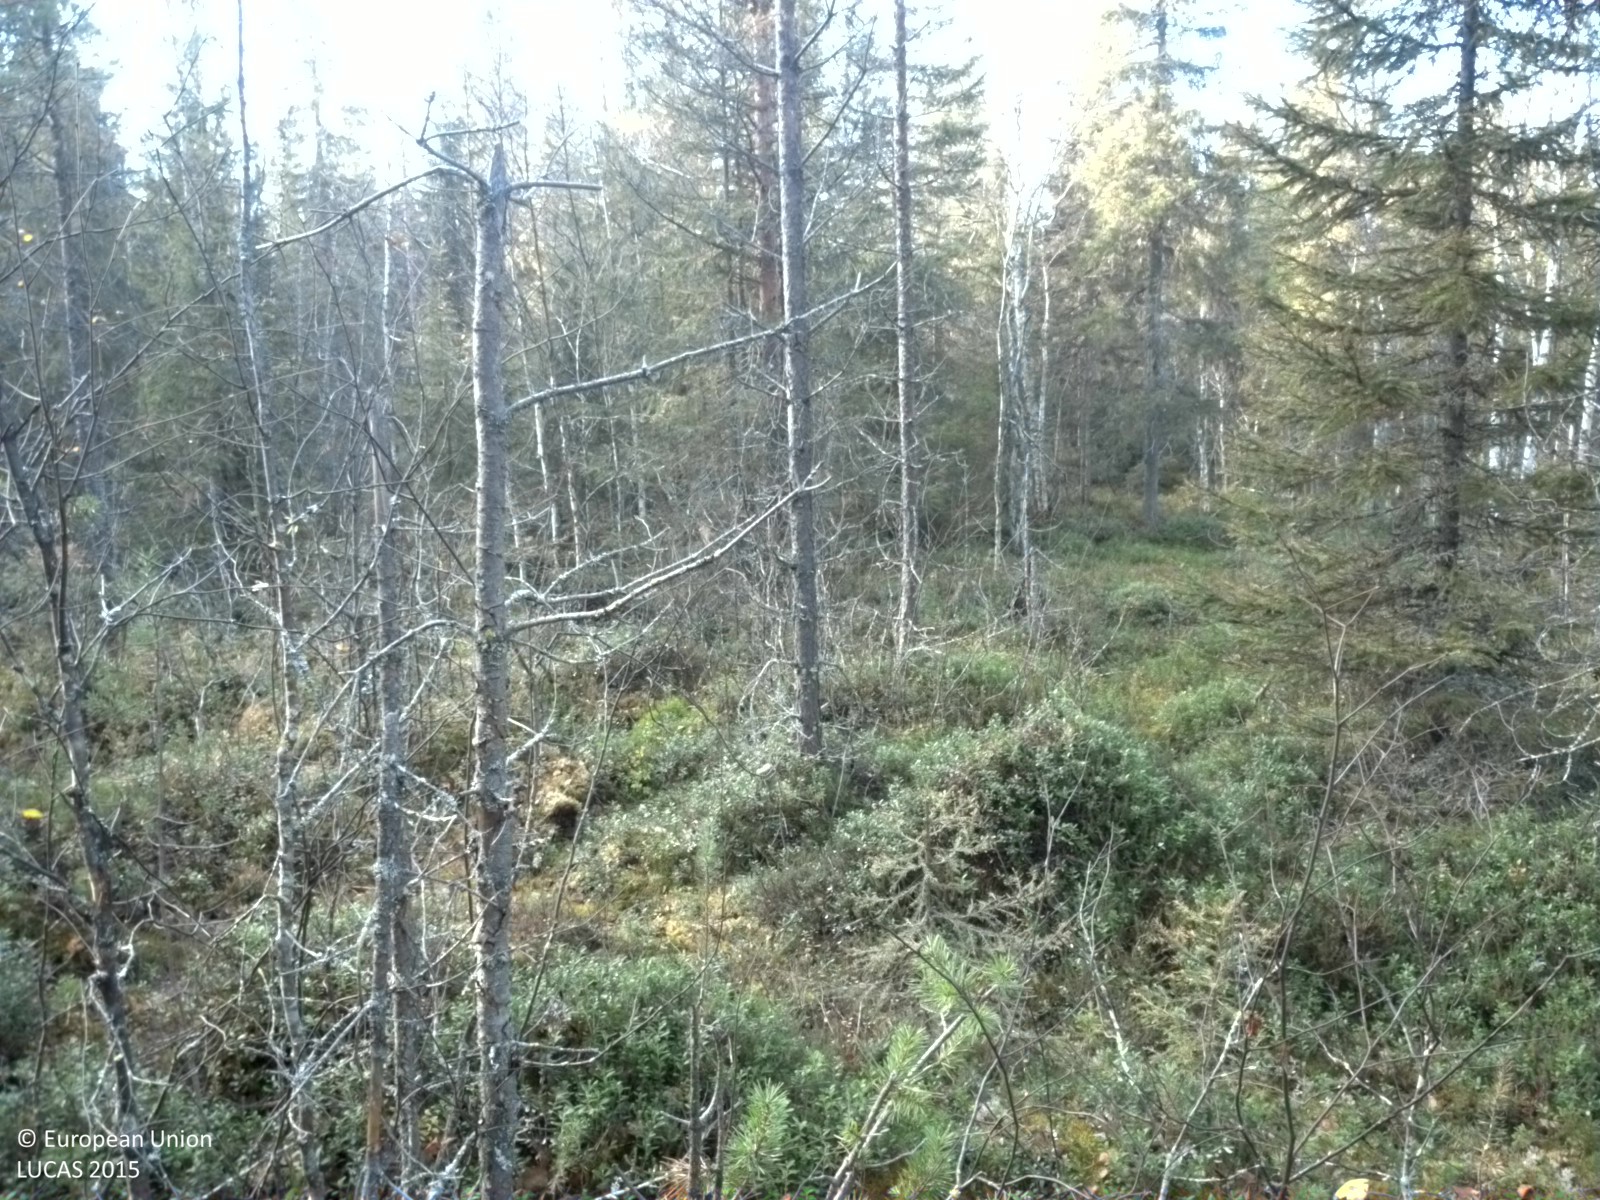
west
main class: Woodland
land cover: Pine dominated coniferous woodland
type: boreal forest
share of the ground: 25 - 50 %
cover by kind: shrubs 60 %, coniferous forest trees 35 %, broadleaved forest trees 5 %
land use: Forestry
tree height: > 5 m
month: October
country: SE
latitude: 65.9587
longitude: 22.2286
